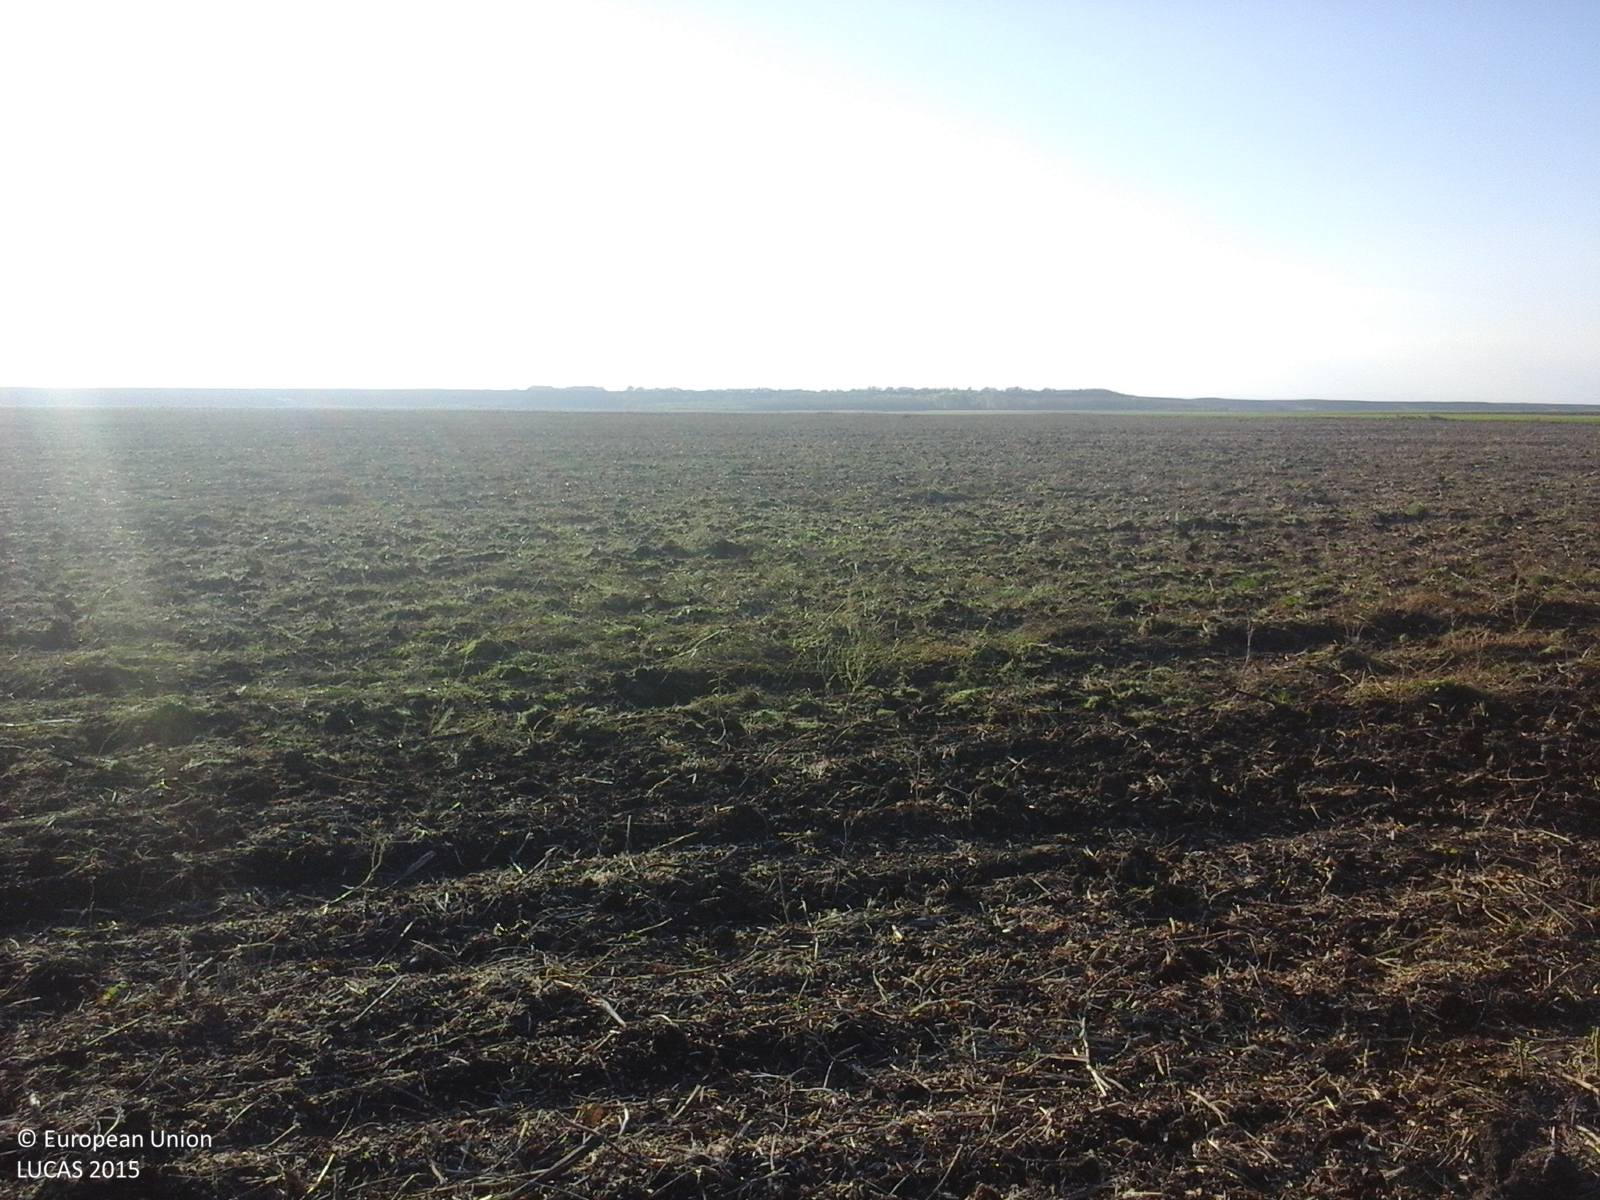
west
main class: Cropland
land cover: Soya
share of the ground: 25 - 50 %
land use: Agriculture (excluding fallow land and kitchen gardens)
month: October
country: RO
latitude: 45.3670
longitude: 27.4246
